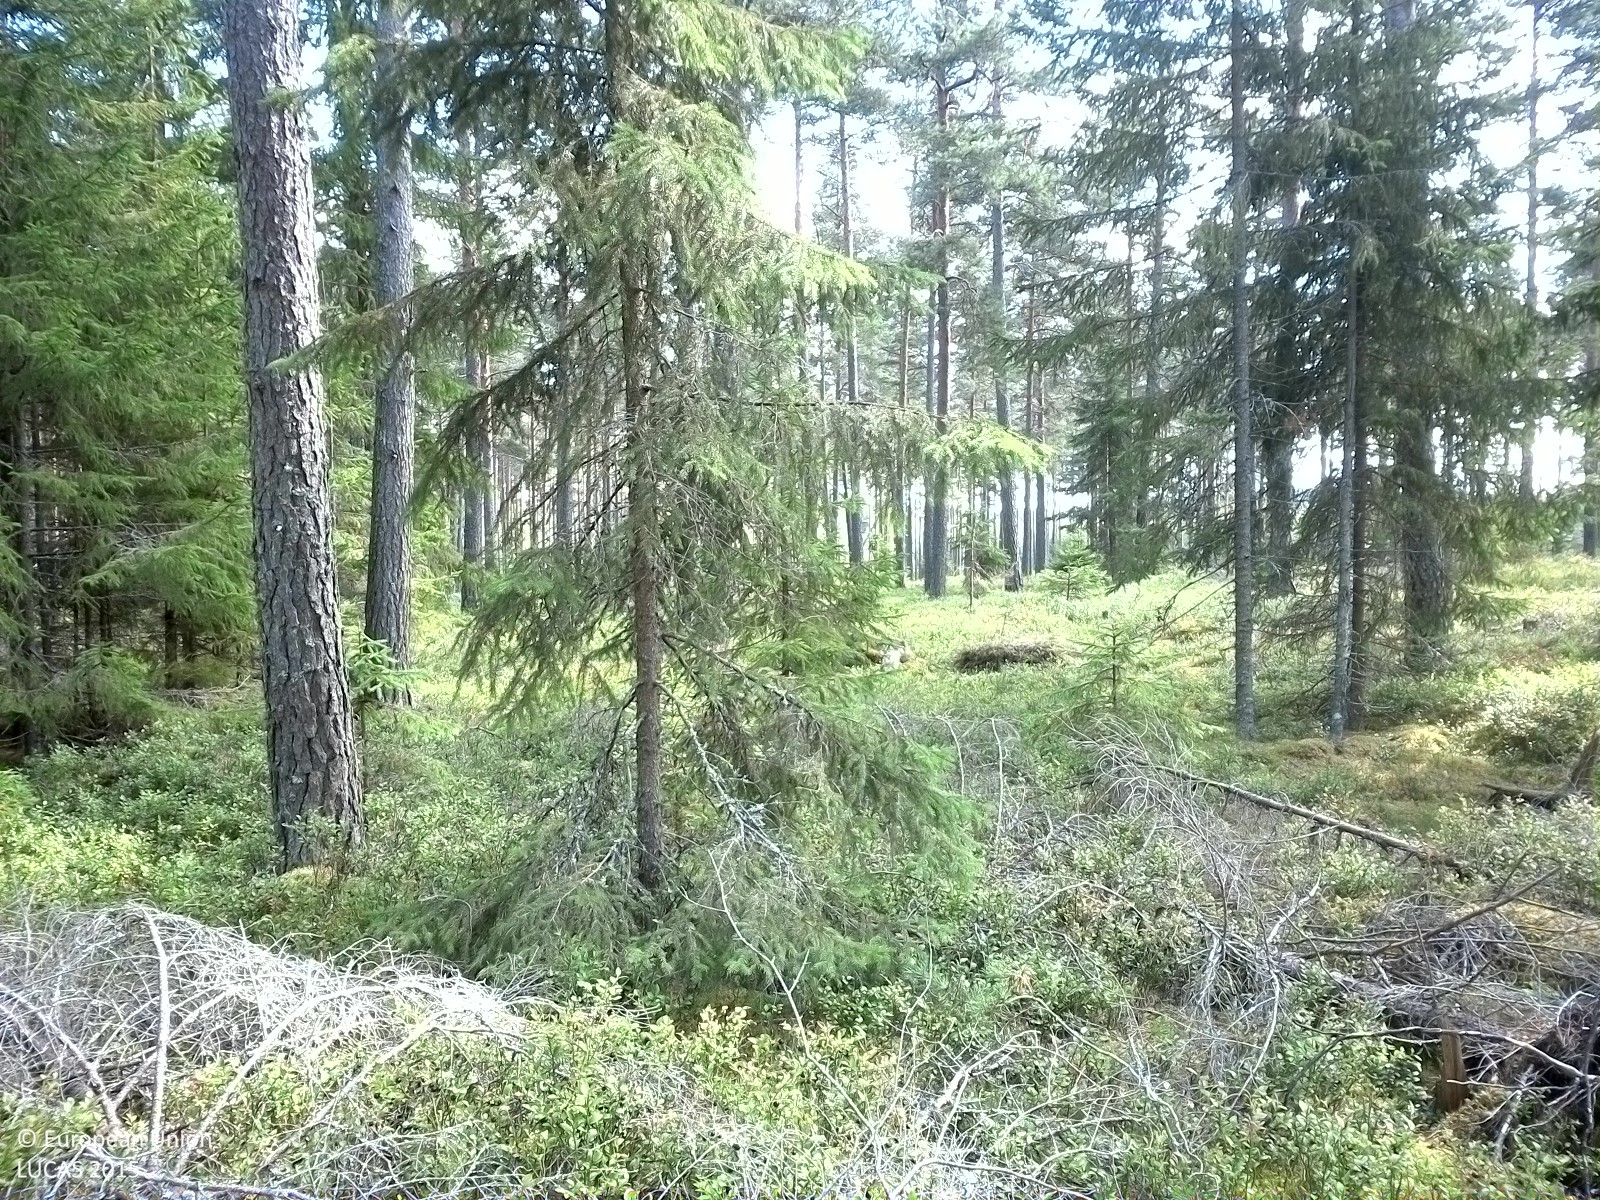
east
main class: Woodland
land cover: Pine dominated coniferous woodland
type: boreal forest
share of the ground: 25 - 50 %
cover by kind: herbaceous plants 40 %, coniferous forest trees 30 %, lichens and mosses 30 %
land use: Forestry
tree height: > 5 m
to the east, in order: Pine dominated coniferous woodland; Tracks; Pine dominated coniferous woodland; Tracks; Pine dominated coniferous woodland; Ditches and canals; Electric lines; Paved roads, cycling and walking lanes; Grass margins; Pine dominated coniferous woodland; Pine dominated mixed woodland
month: August
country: SE
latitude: 58.8856
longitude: 15.4235
